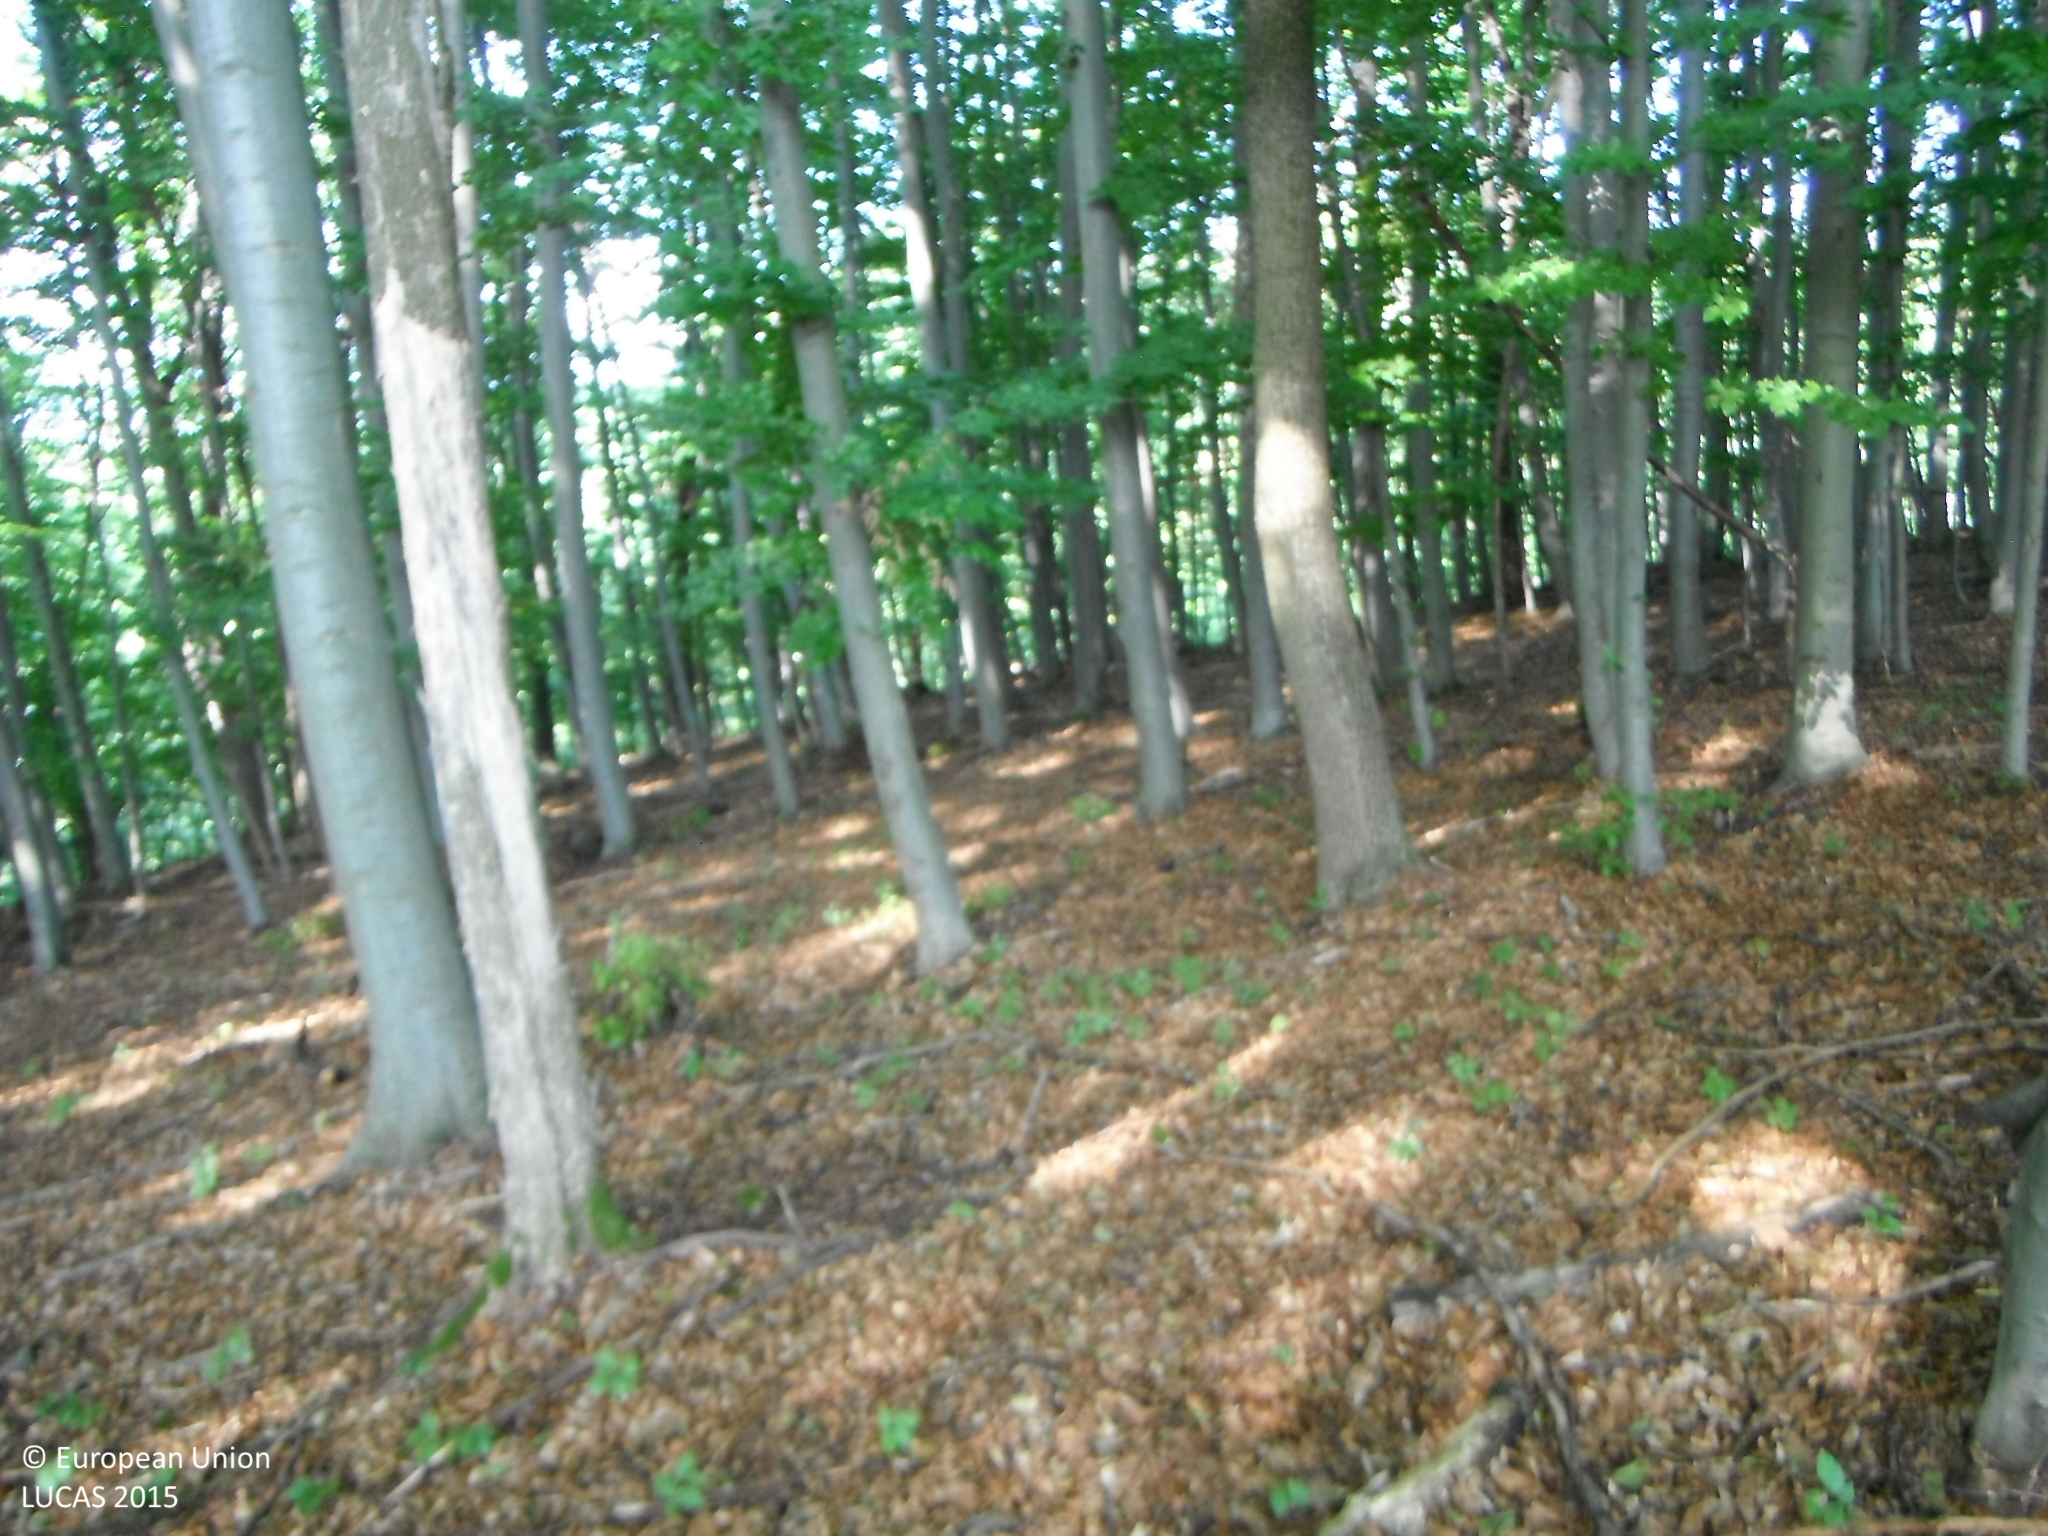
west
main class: Woodland
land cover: Broadleaved woodland
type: beech forest
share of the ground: > 75 %
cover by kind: broadleaved forest trees 90 %, consolidated bare surface 5 %
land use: Forestry
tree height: > 5 m
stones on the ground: < 10 %
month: September
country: SK
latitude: 48.7959
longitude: 18.3065
